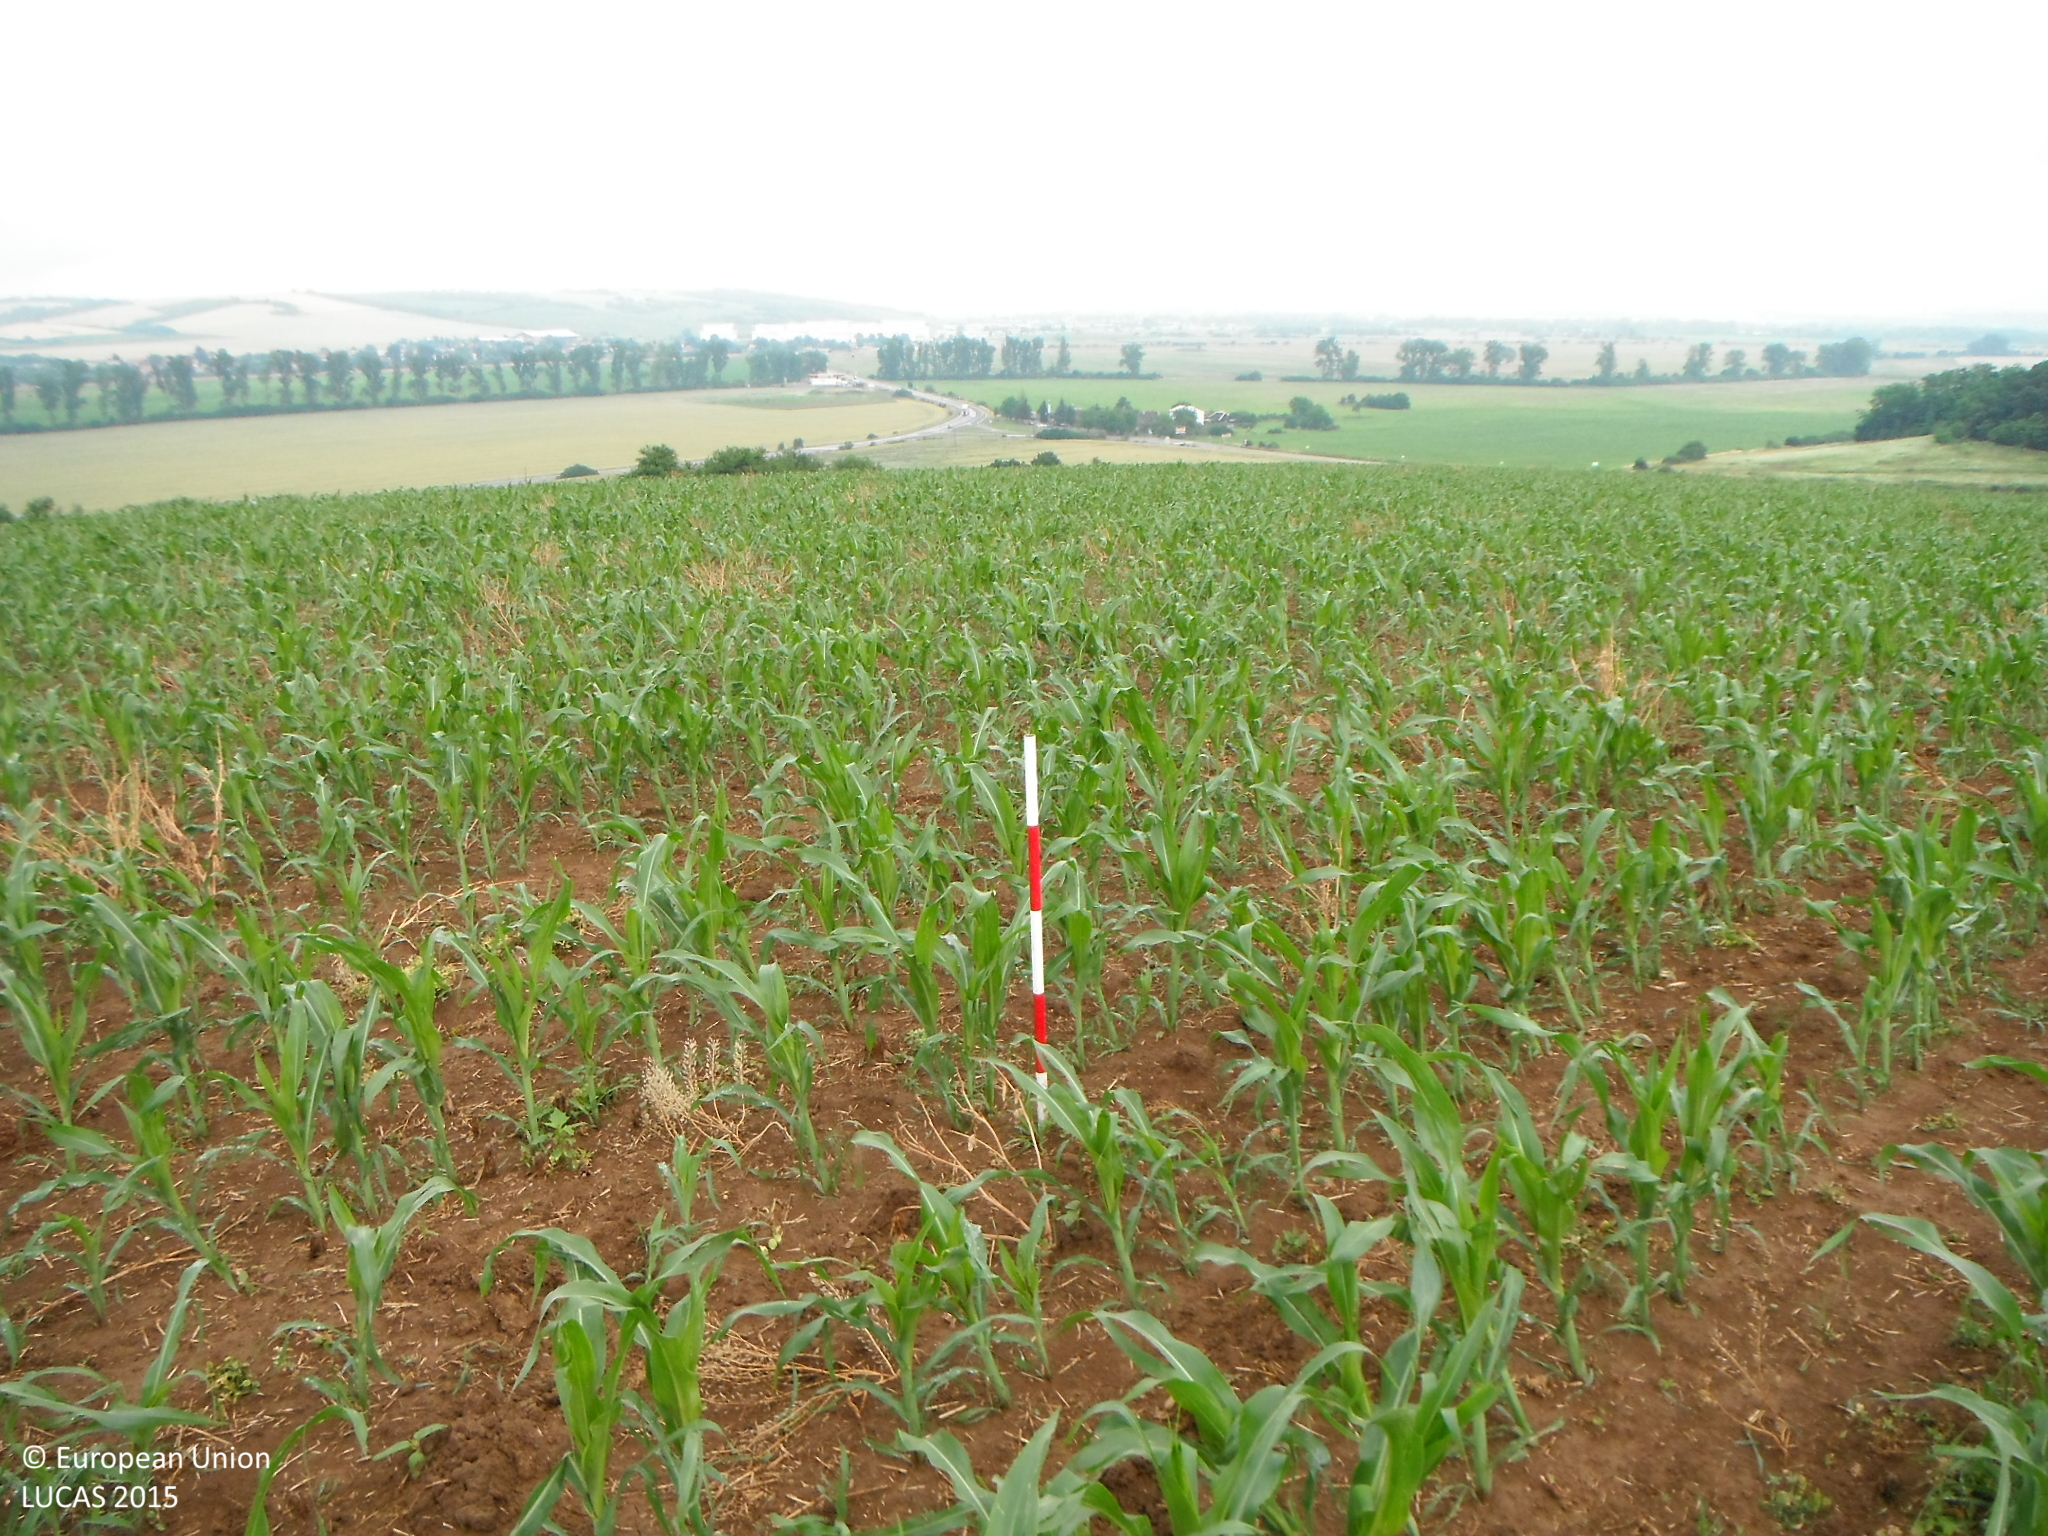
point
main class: Cropland
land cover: Maize
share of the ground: 50 - 75 %
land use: Agriculture (excluding fallow land and kitchen gardens)
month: June
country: SK
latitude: 48.1188
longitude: 18.8711
